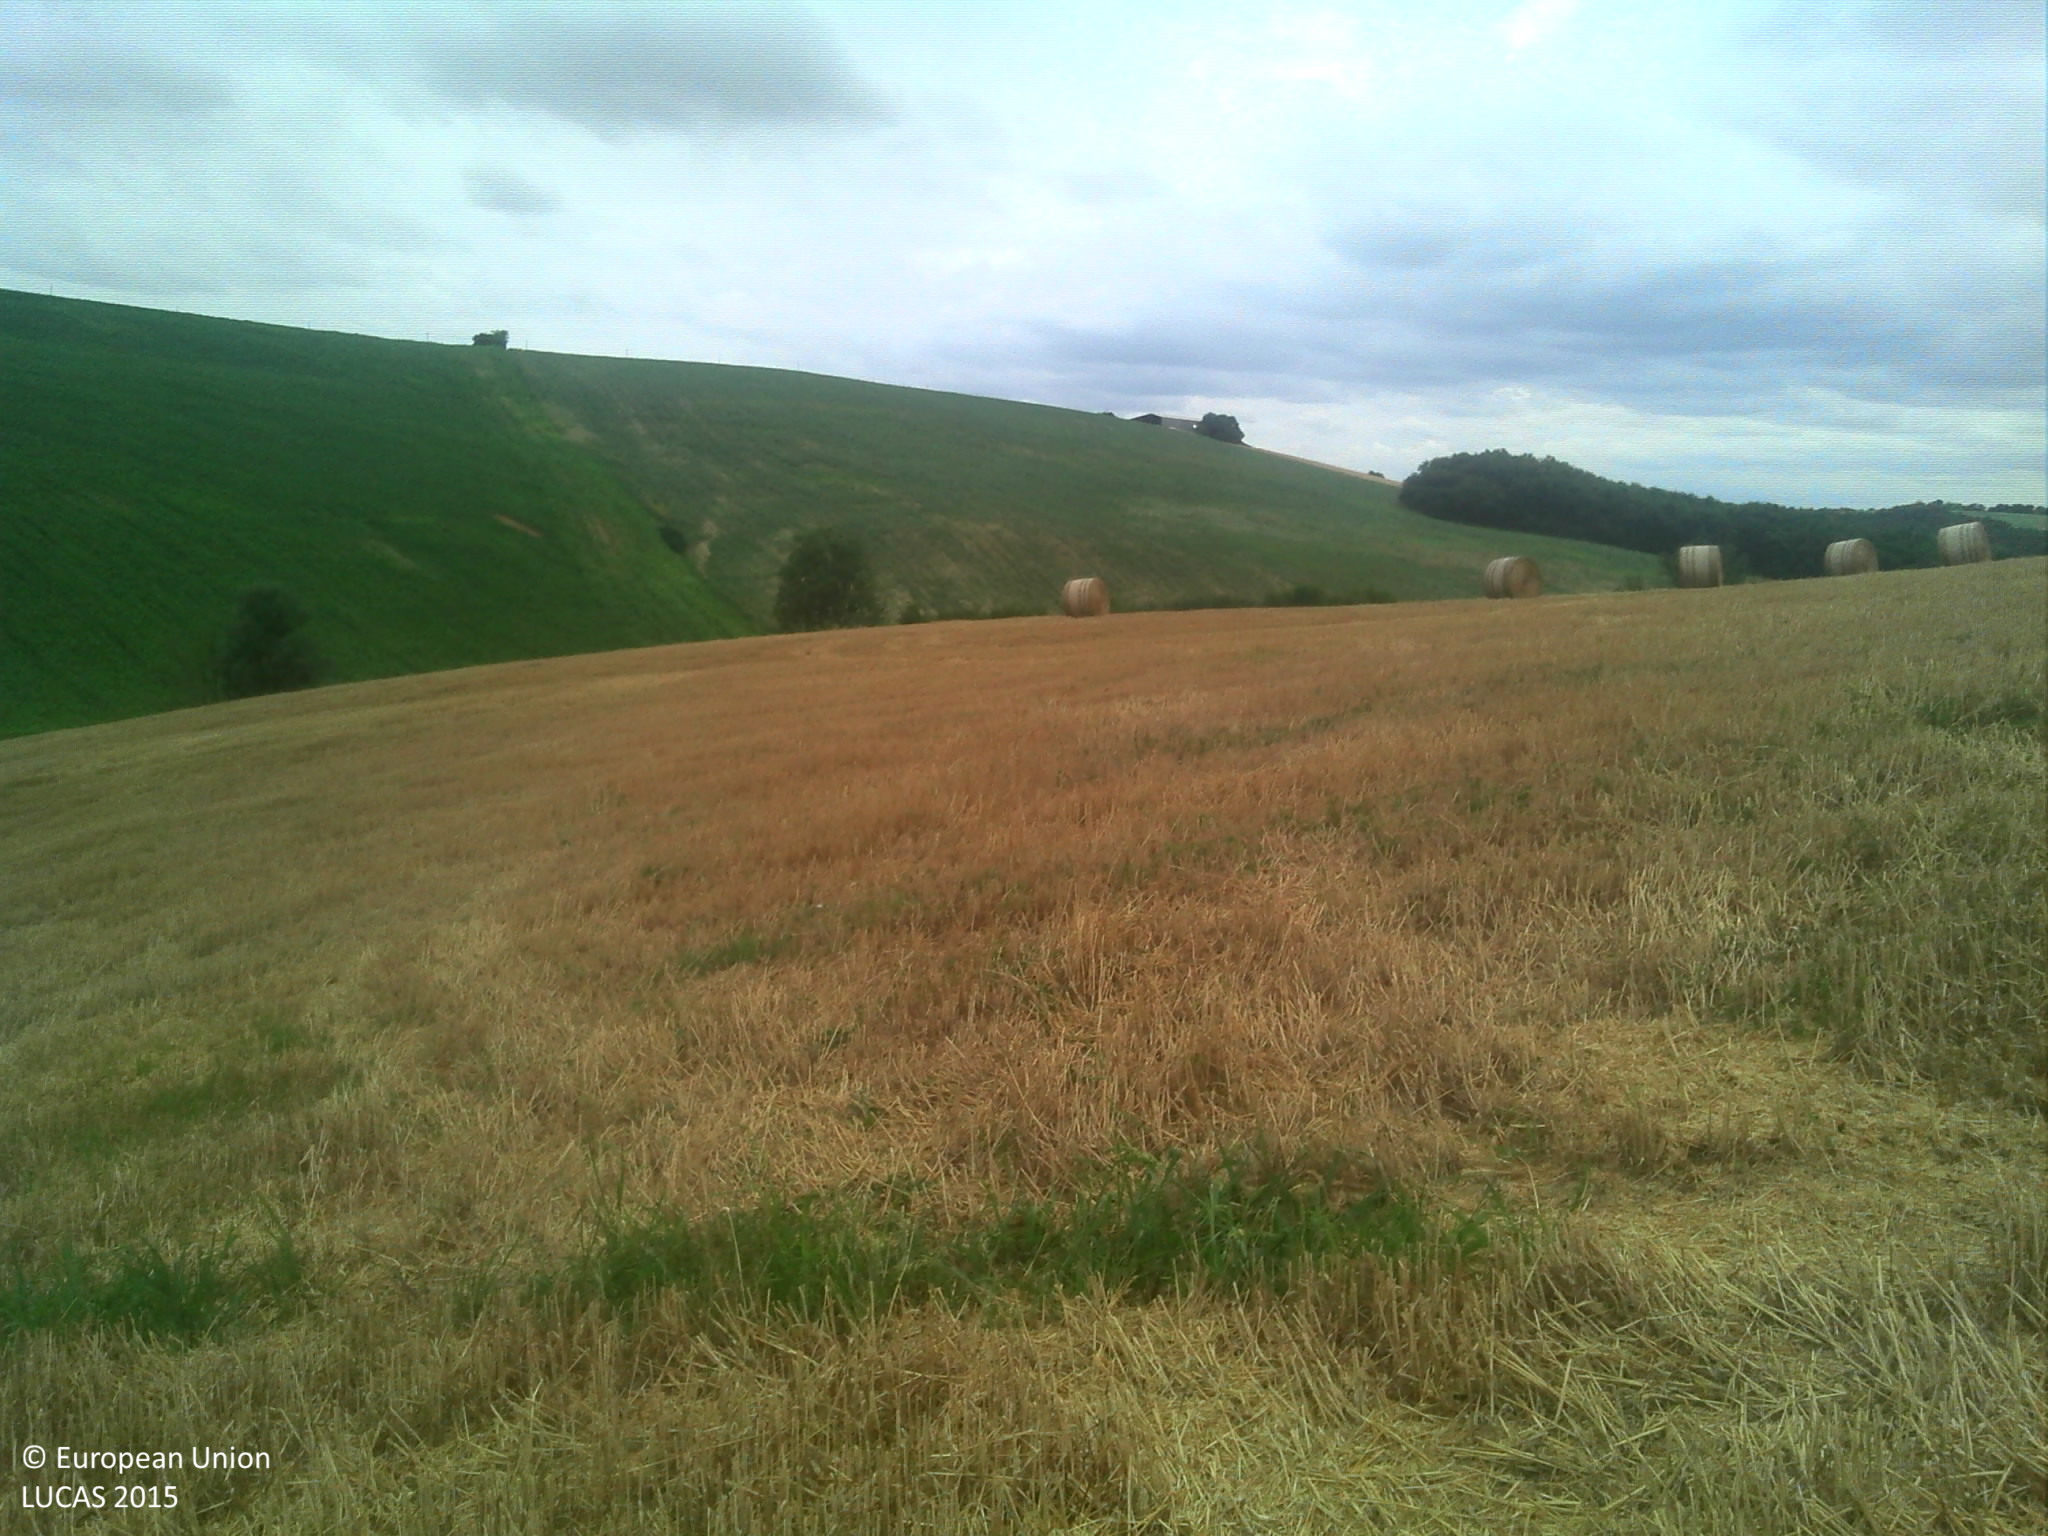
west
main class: Cropland
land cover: Common wheat
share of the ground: > 75 %
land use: Agriculture (excluding fallow land and kitchen gardens)
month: July
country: FR
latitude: 43.2849
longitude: 1.3898
